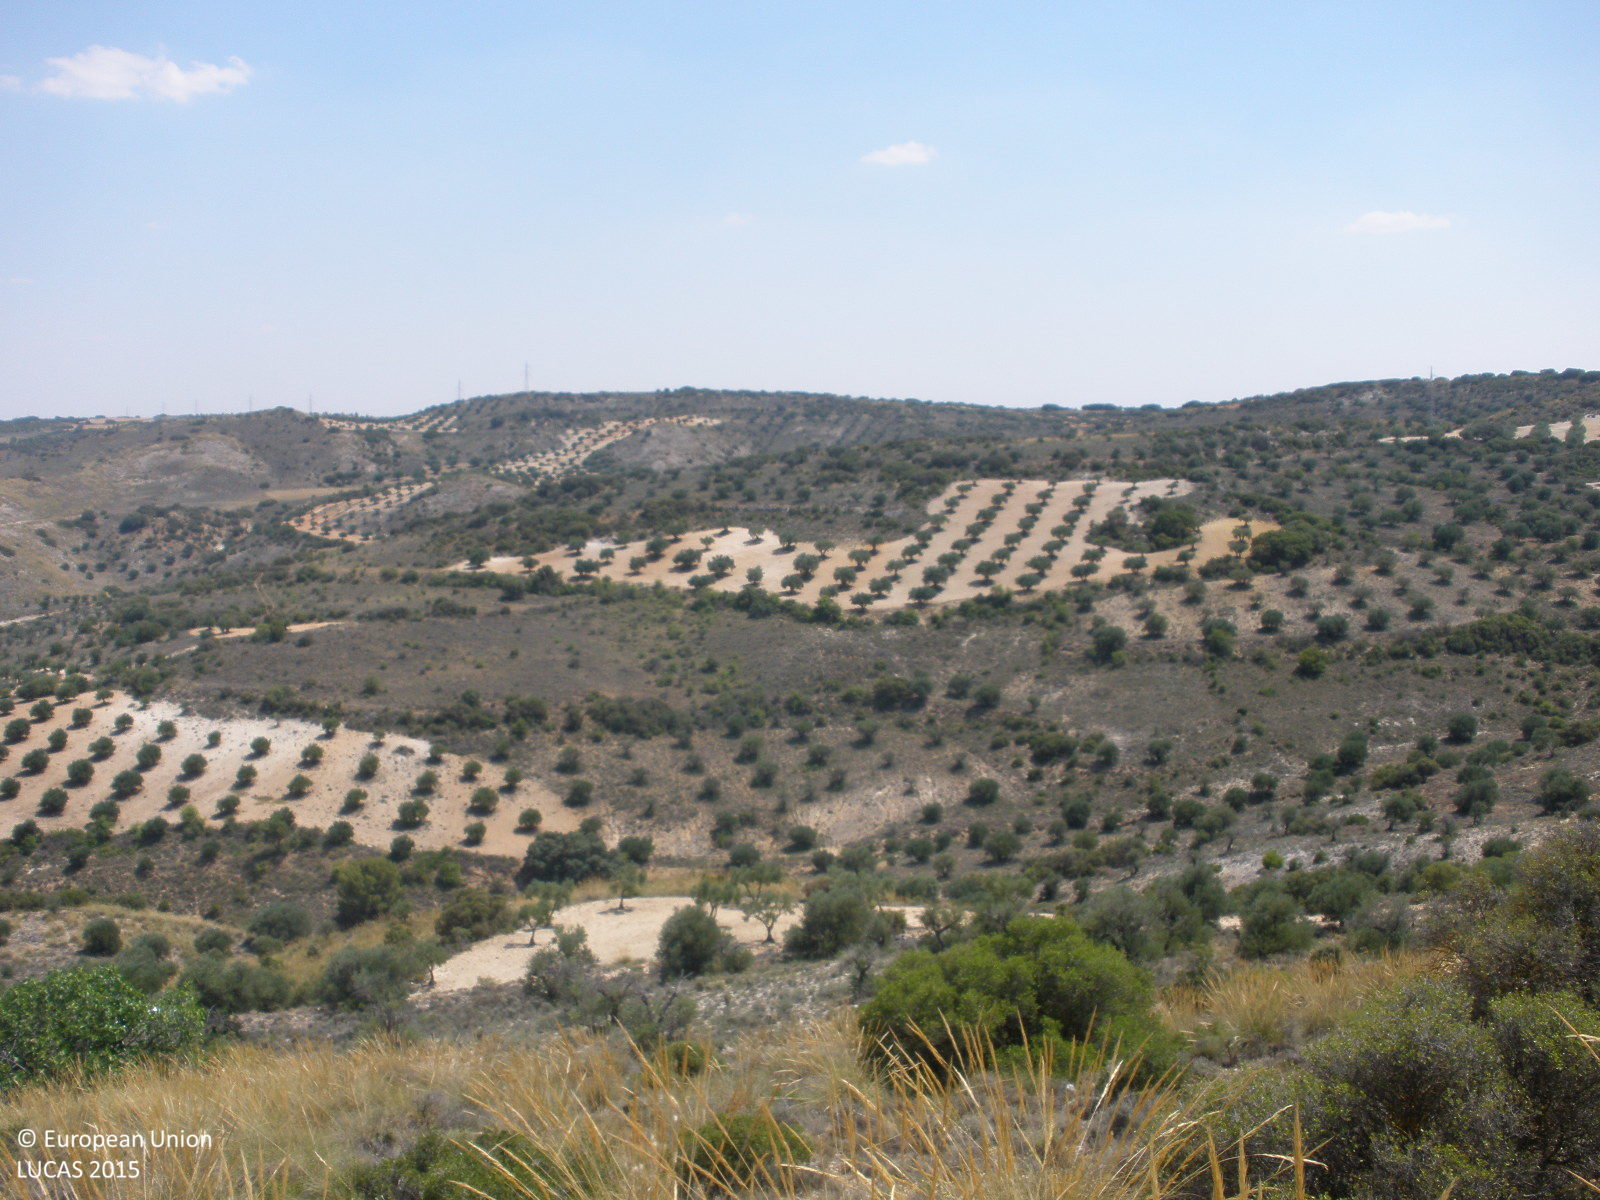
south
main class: Woodland
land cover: Broadleaved woodland
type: broadleaved evergreen forest
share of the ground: 25 - 50 %
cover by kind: herbaceous plants 45 %, broadleaved forest trees 30 %, shrubs 20 %, consolidated bare surface 5 %
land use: Semi-natural and natural areas not in use
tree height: < 5 m
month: June
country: ES
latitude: 40.2246
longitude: -3.2502
